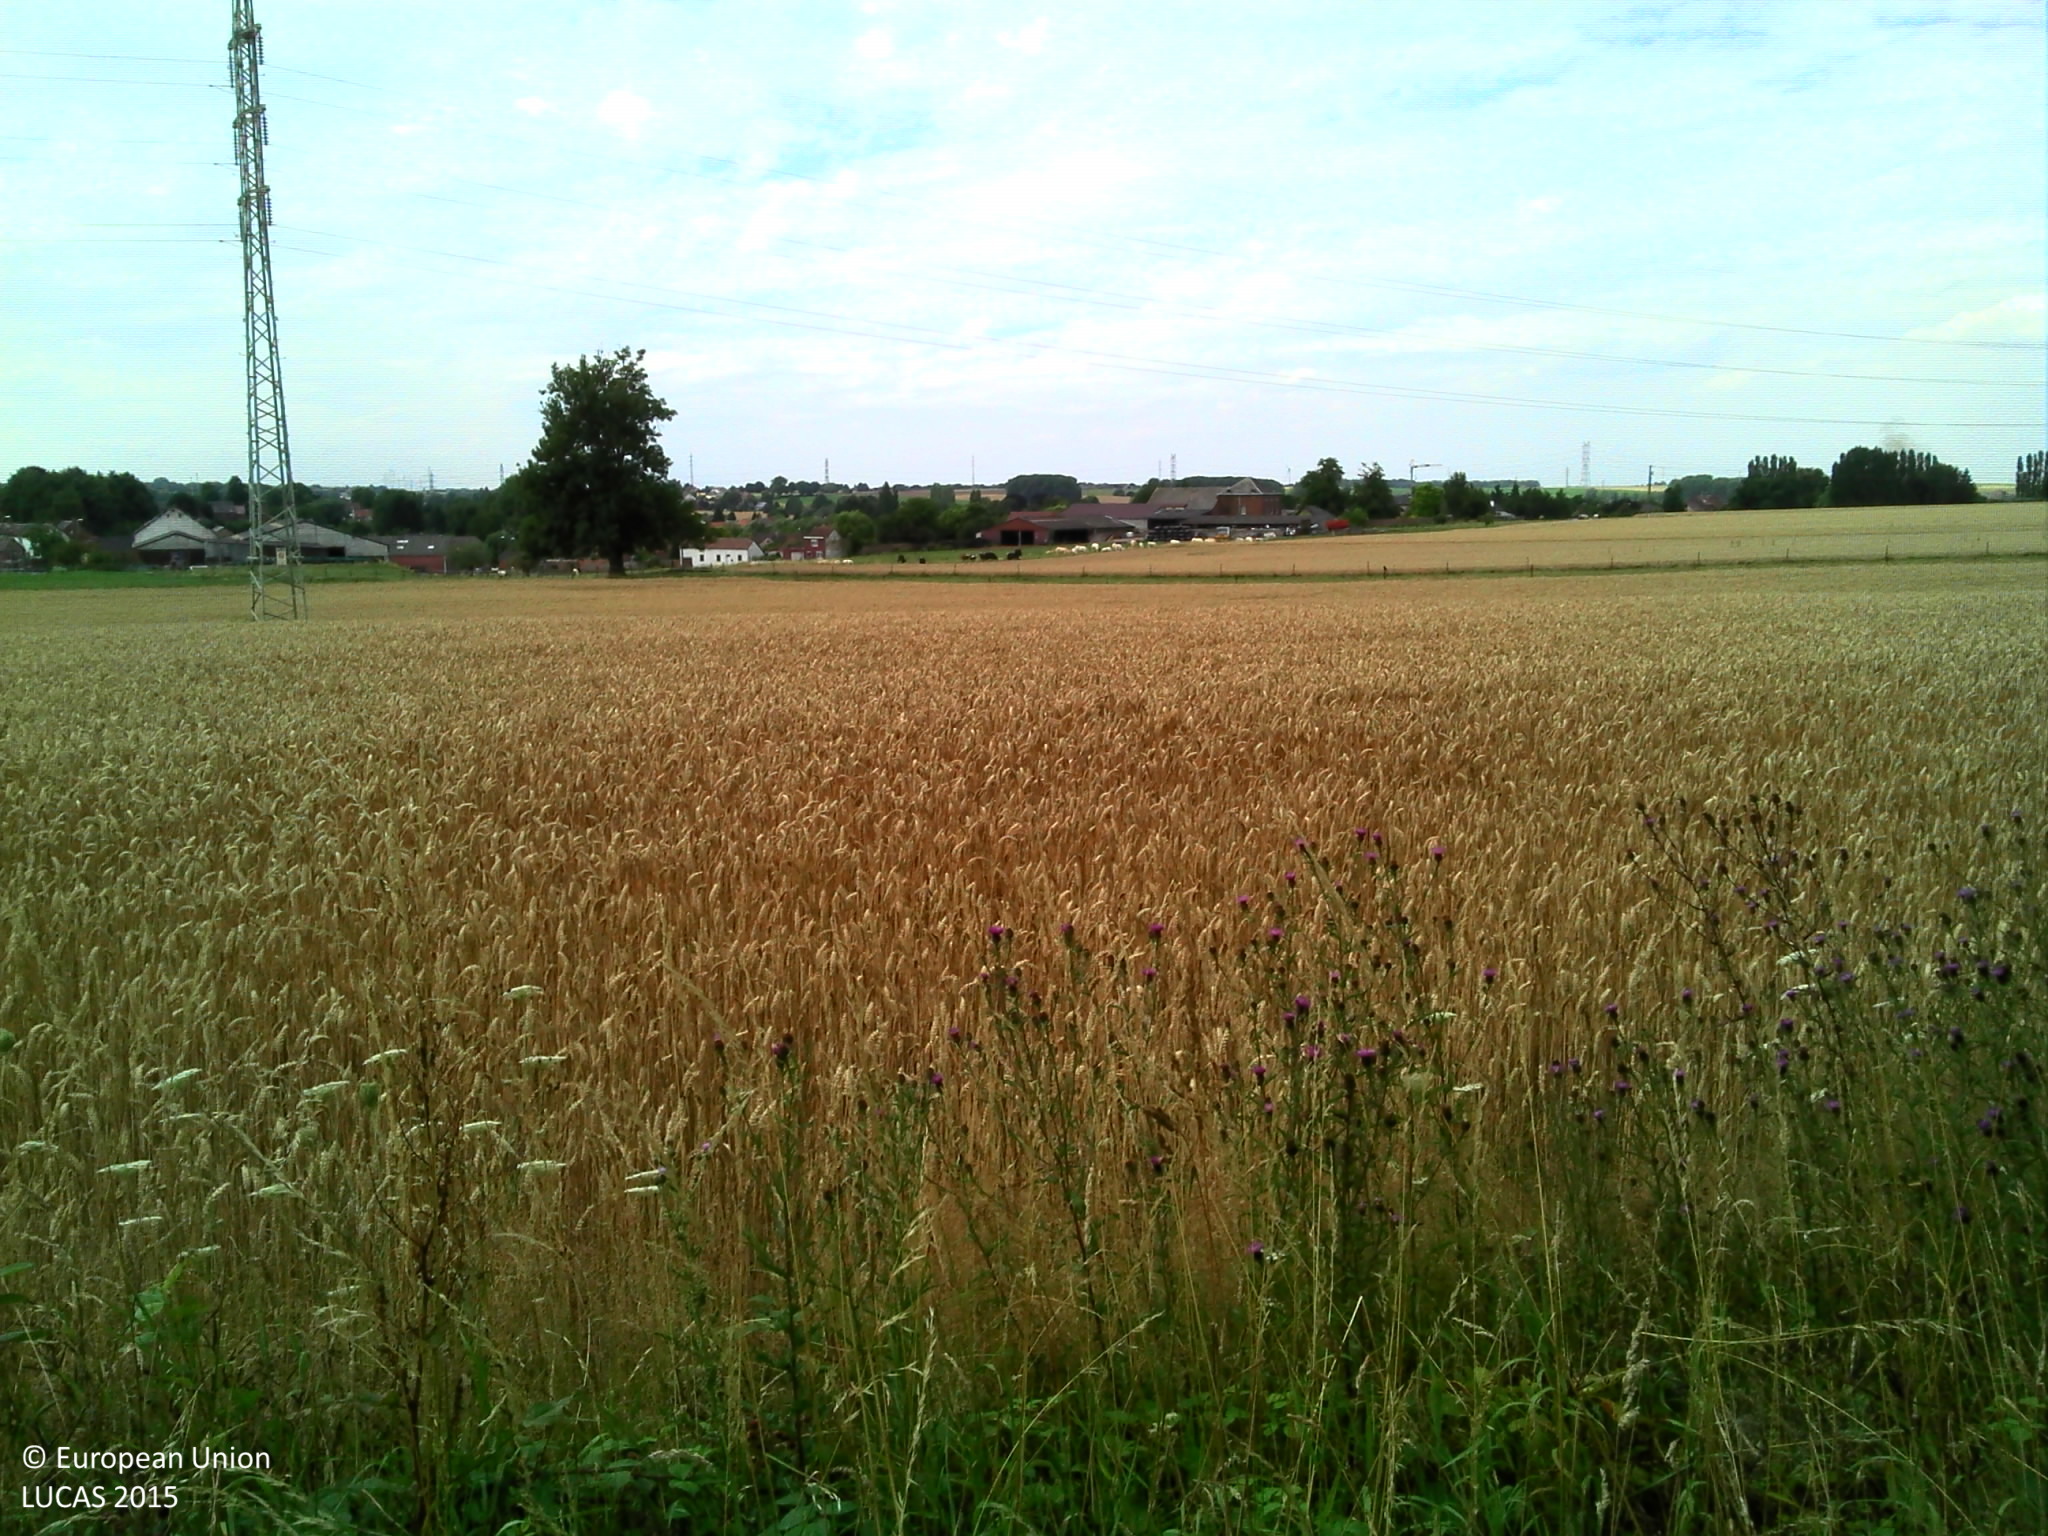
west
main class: Woodland
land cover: Broadleaved woodland
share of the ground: > 75 %
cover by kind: broadleaved forest trees 60 %, herbaceous plants 40 %
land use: Semi-natural and natural areas not in use
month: July
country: BE
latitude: 50.4945
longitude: 4.3426
